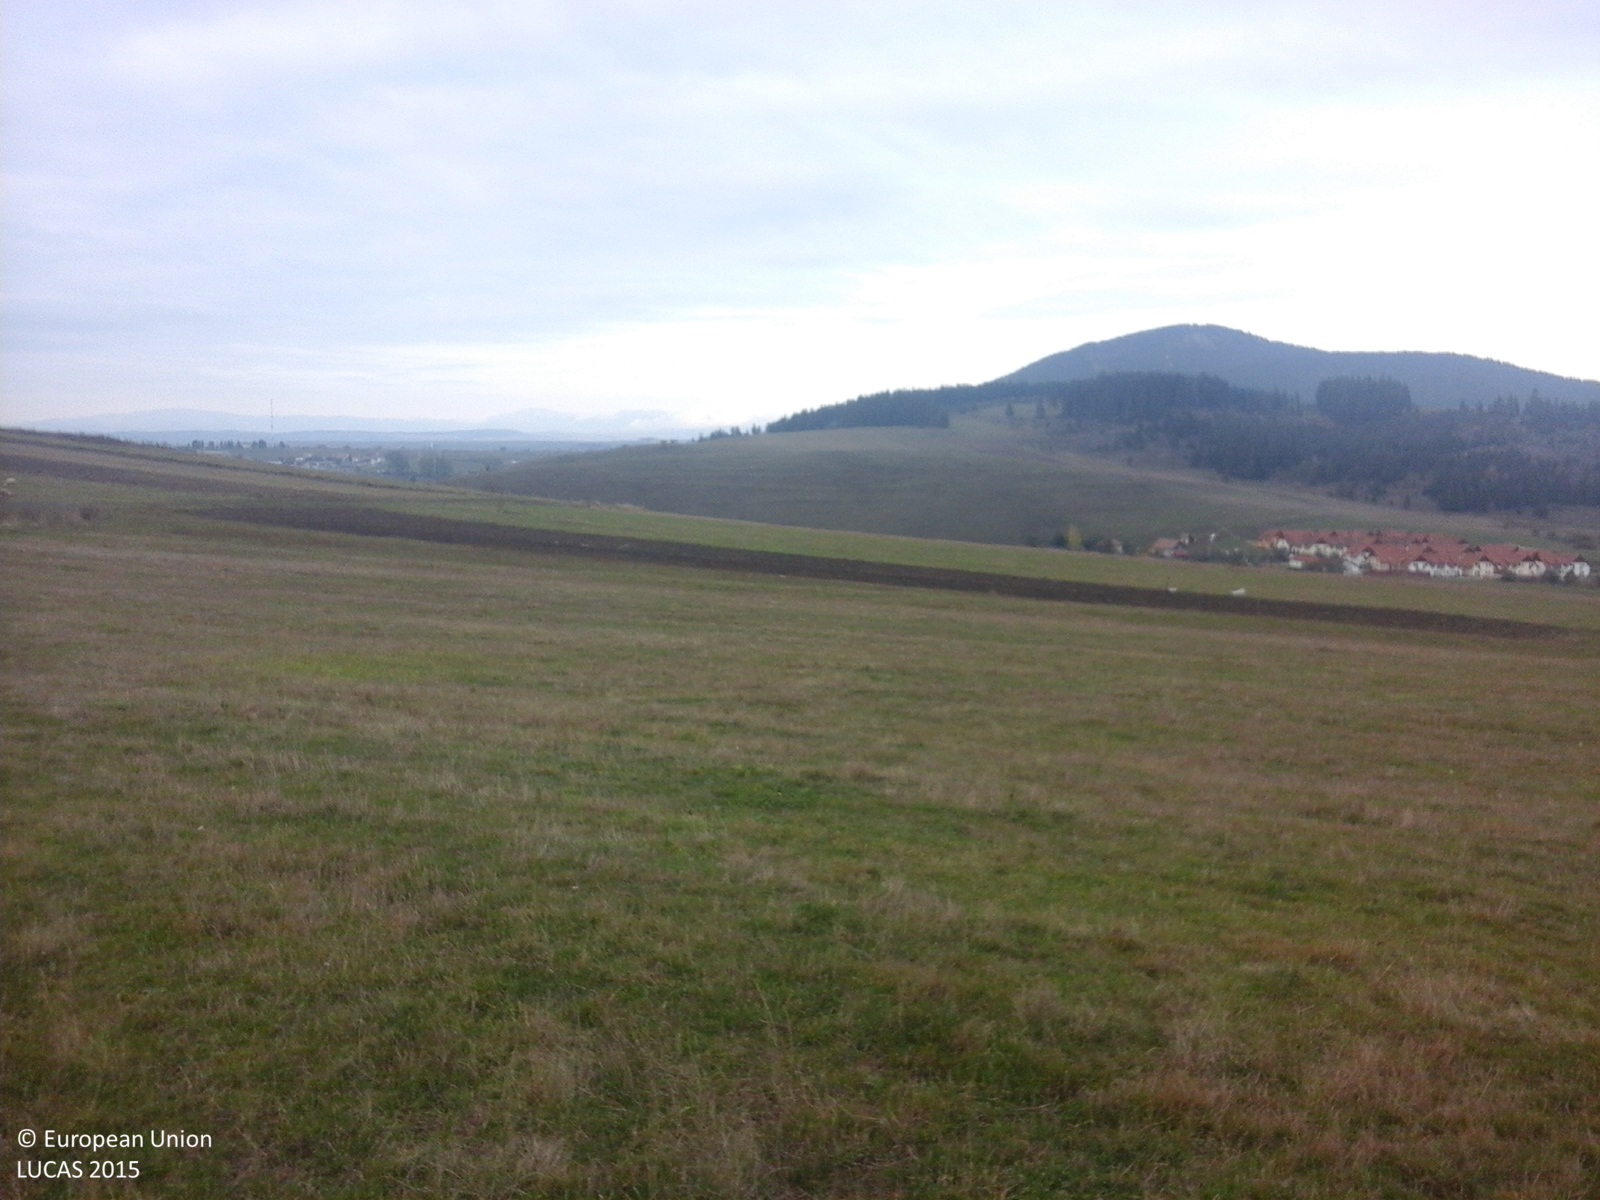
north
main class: Grassland
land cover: Grassland without tree/shrub cover
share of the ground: > 75 %
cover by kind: herbaceous plants 100 %
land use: Agriculture (excluding fallow land and kitchen gardens)
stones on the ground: < 10 %
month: October
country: RO
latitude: 46.3379
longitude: 25.8223
